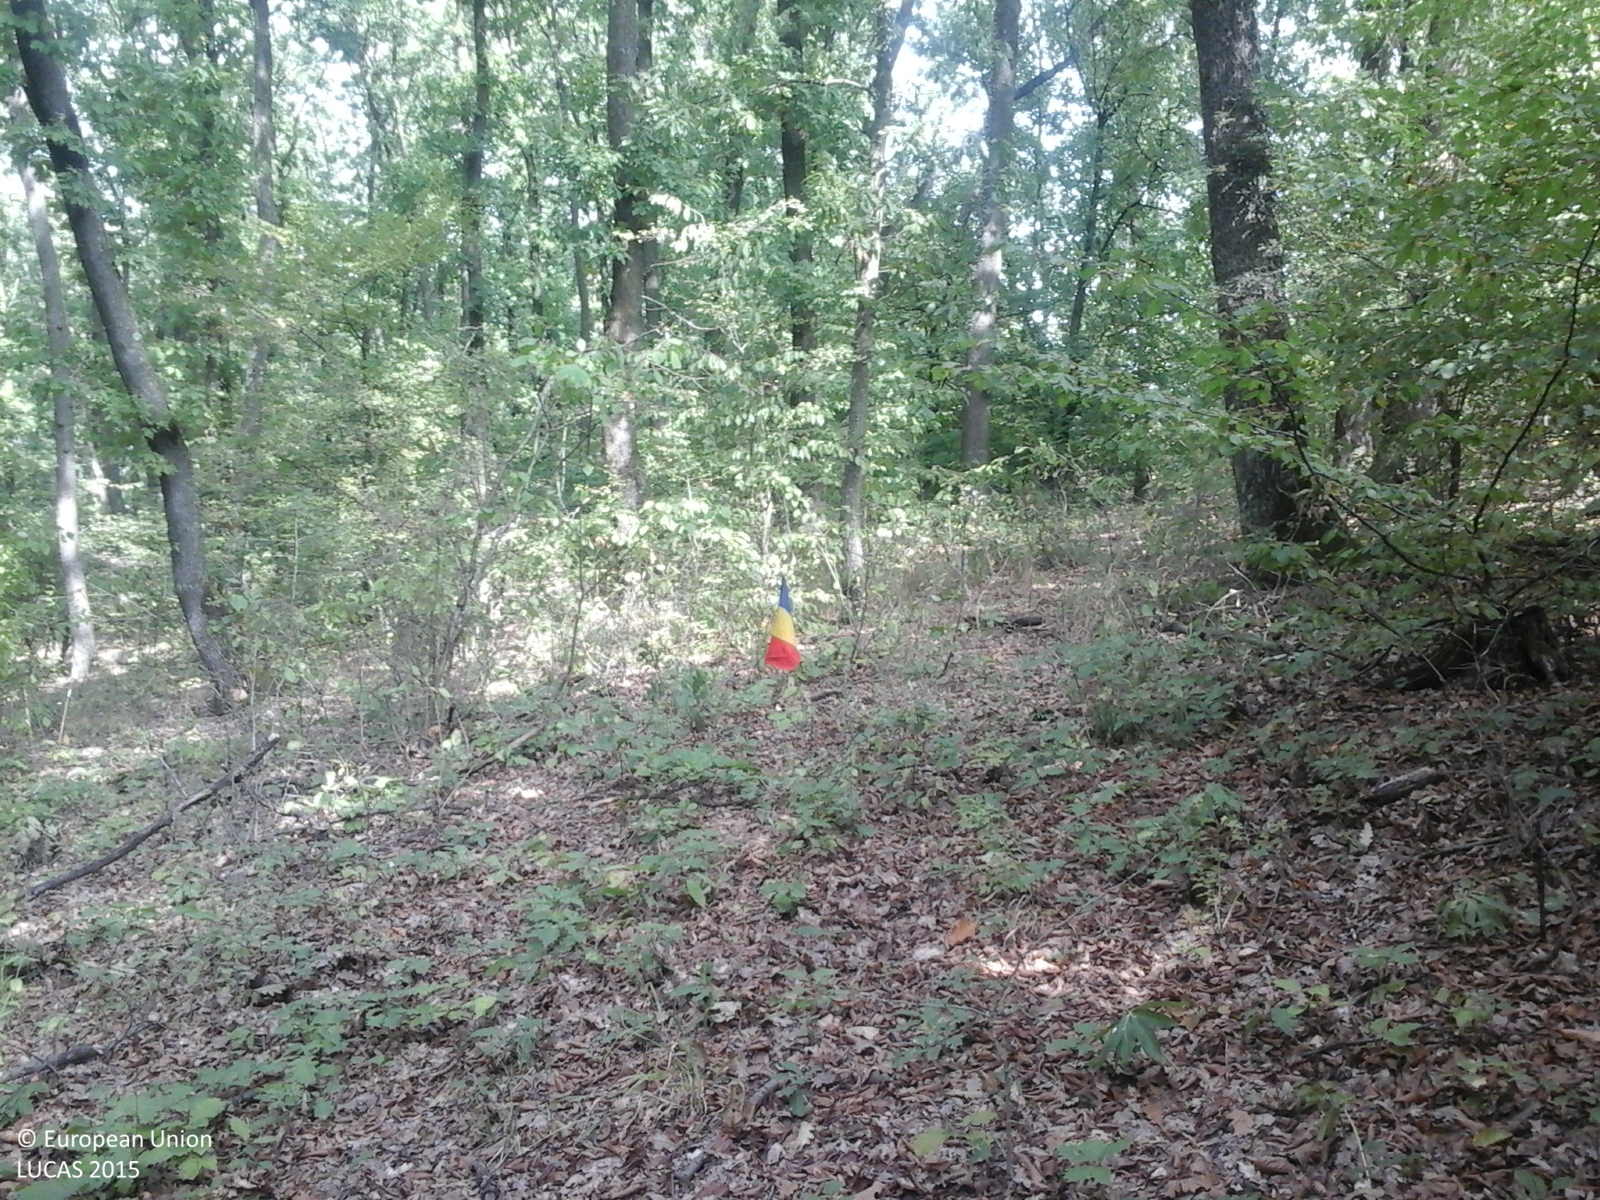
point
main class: Woodland
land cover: Broadleaved woodland
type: acidophilous oak and oak-birch forest
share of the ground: > 75 %
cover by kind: broadleaved forest trees 100 %
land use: Forestry
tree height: > 5 m
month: September
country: RO
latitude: 47.1261
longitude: 23.2627
